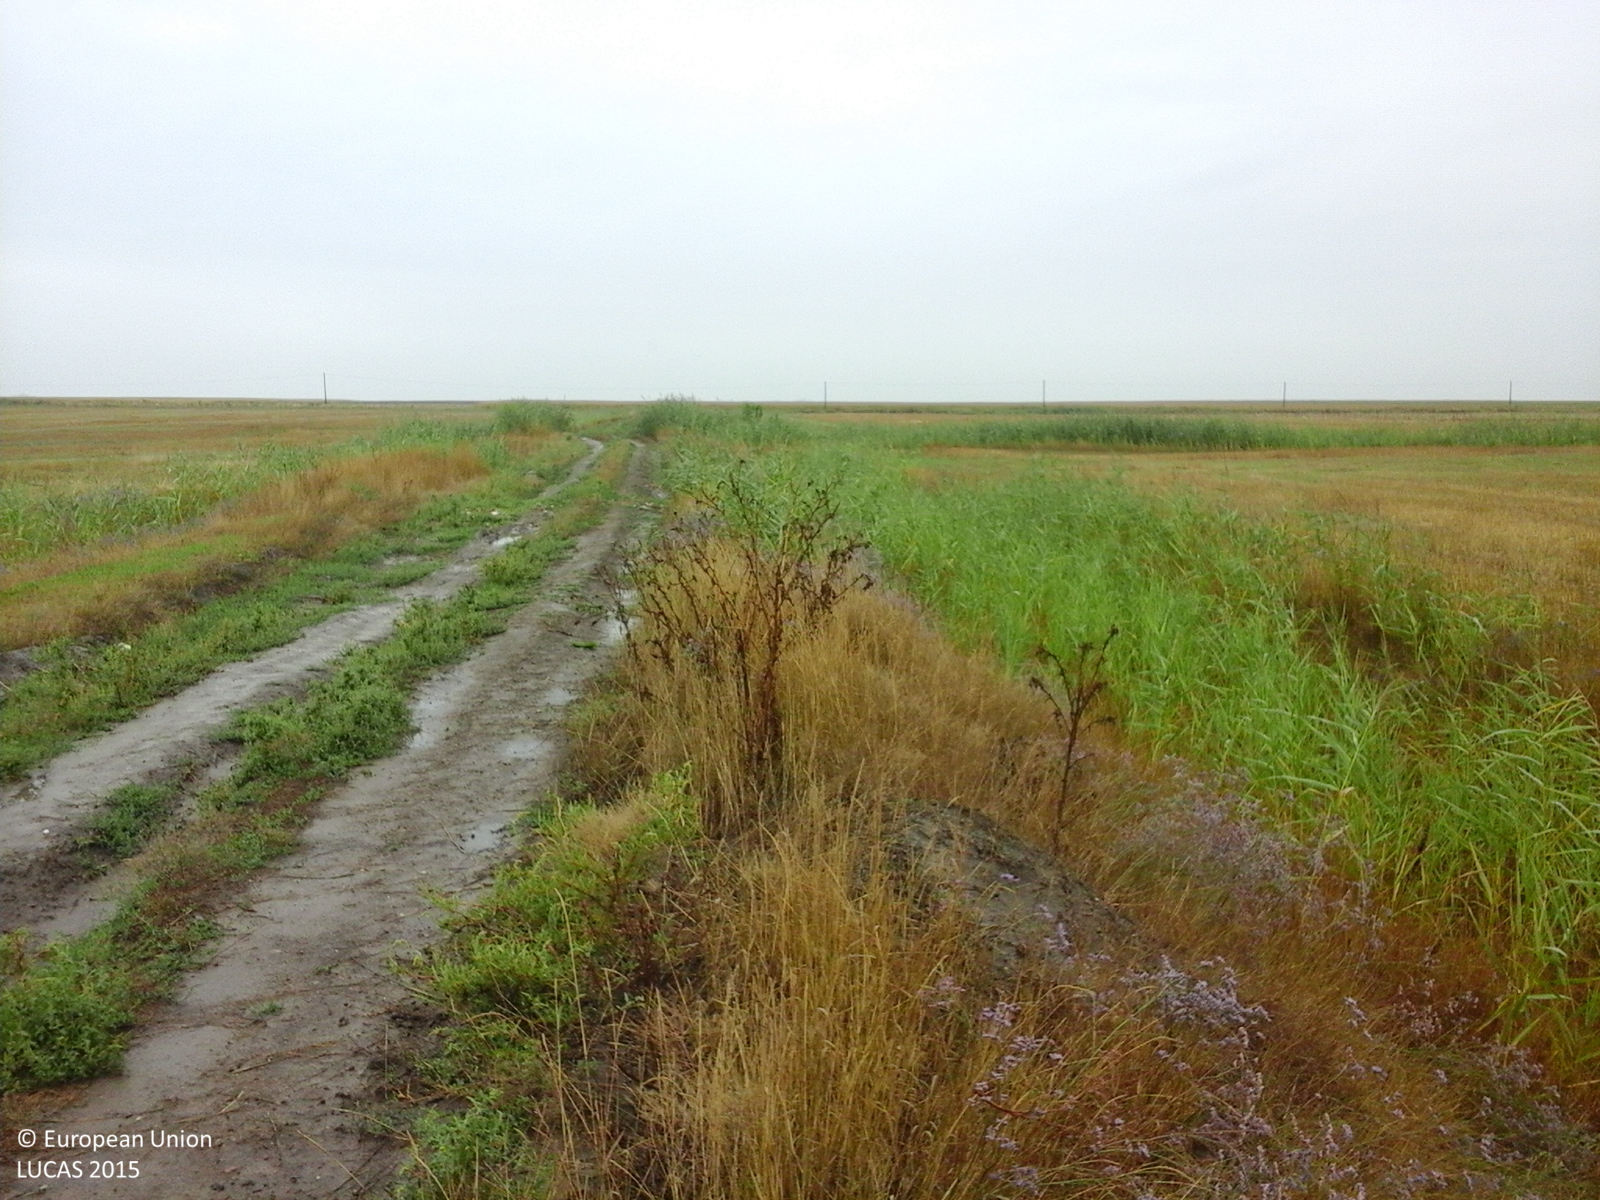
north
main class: Cropland
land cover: Common wheat
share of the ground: < 10 %
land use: Agriculture (excluding fallow land and kitchen gardens)
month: August
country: RO
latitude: 45.6015
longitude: 20.9888
